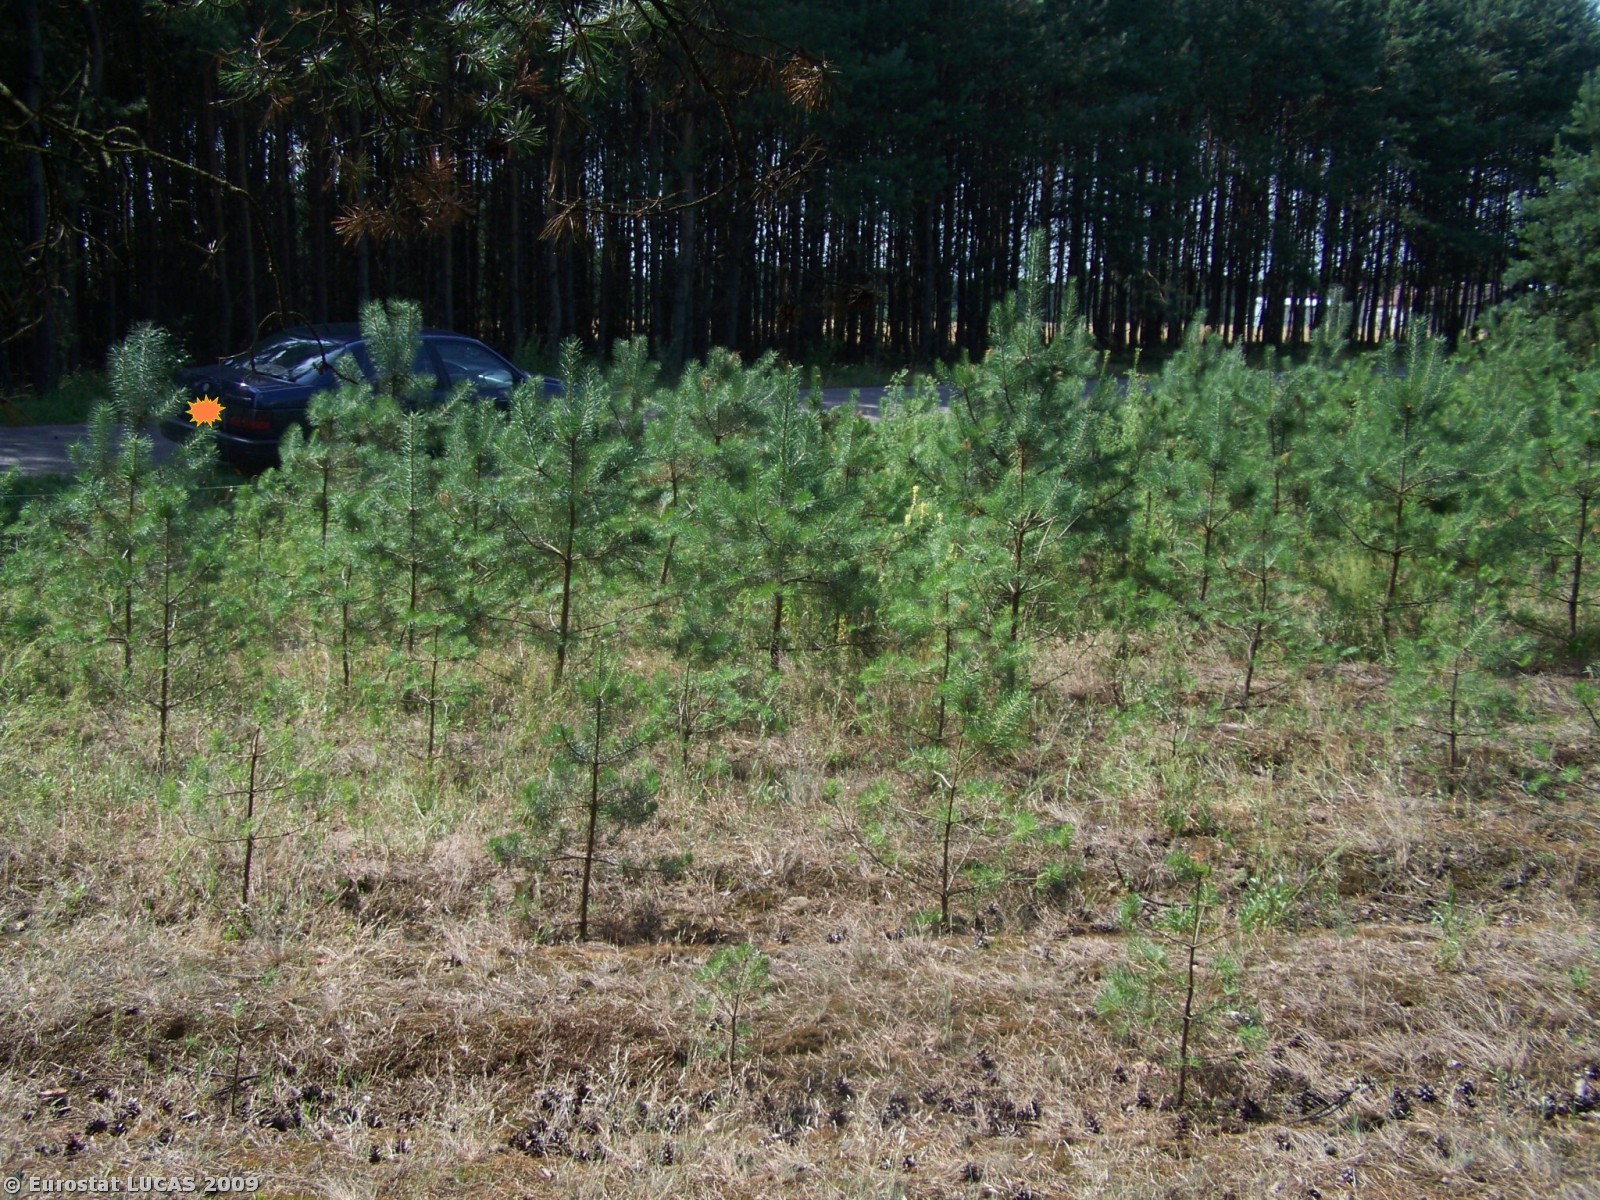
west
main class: Woodland
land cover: Coniferous woodland
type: hemiboreal forest and nemoral coniferous forest and mixed broadleaved-coniferous forest
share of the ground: > 75 %
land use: Forestry
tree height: > 5 m
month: July
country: PL
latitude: 52.0772
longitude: 22.1568
